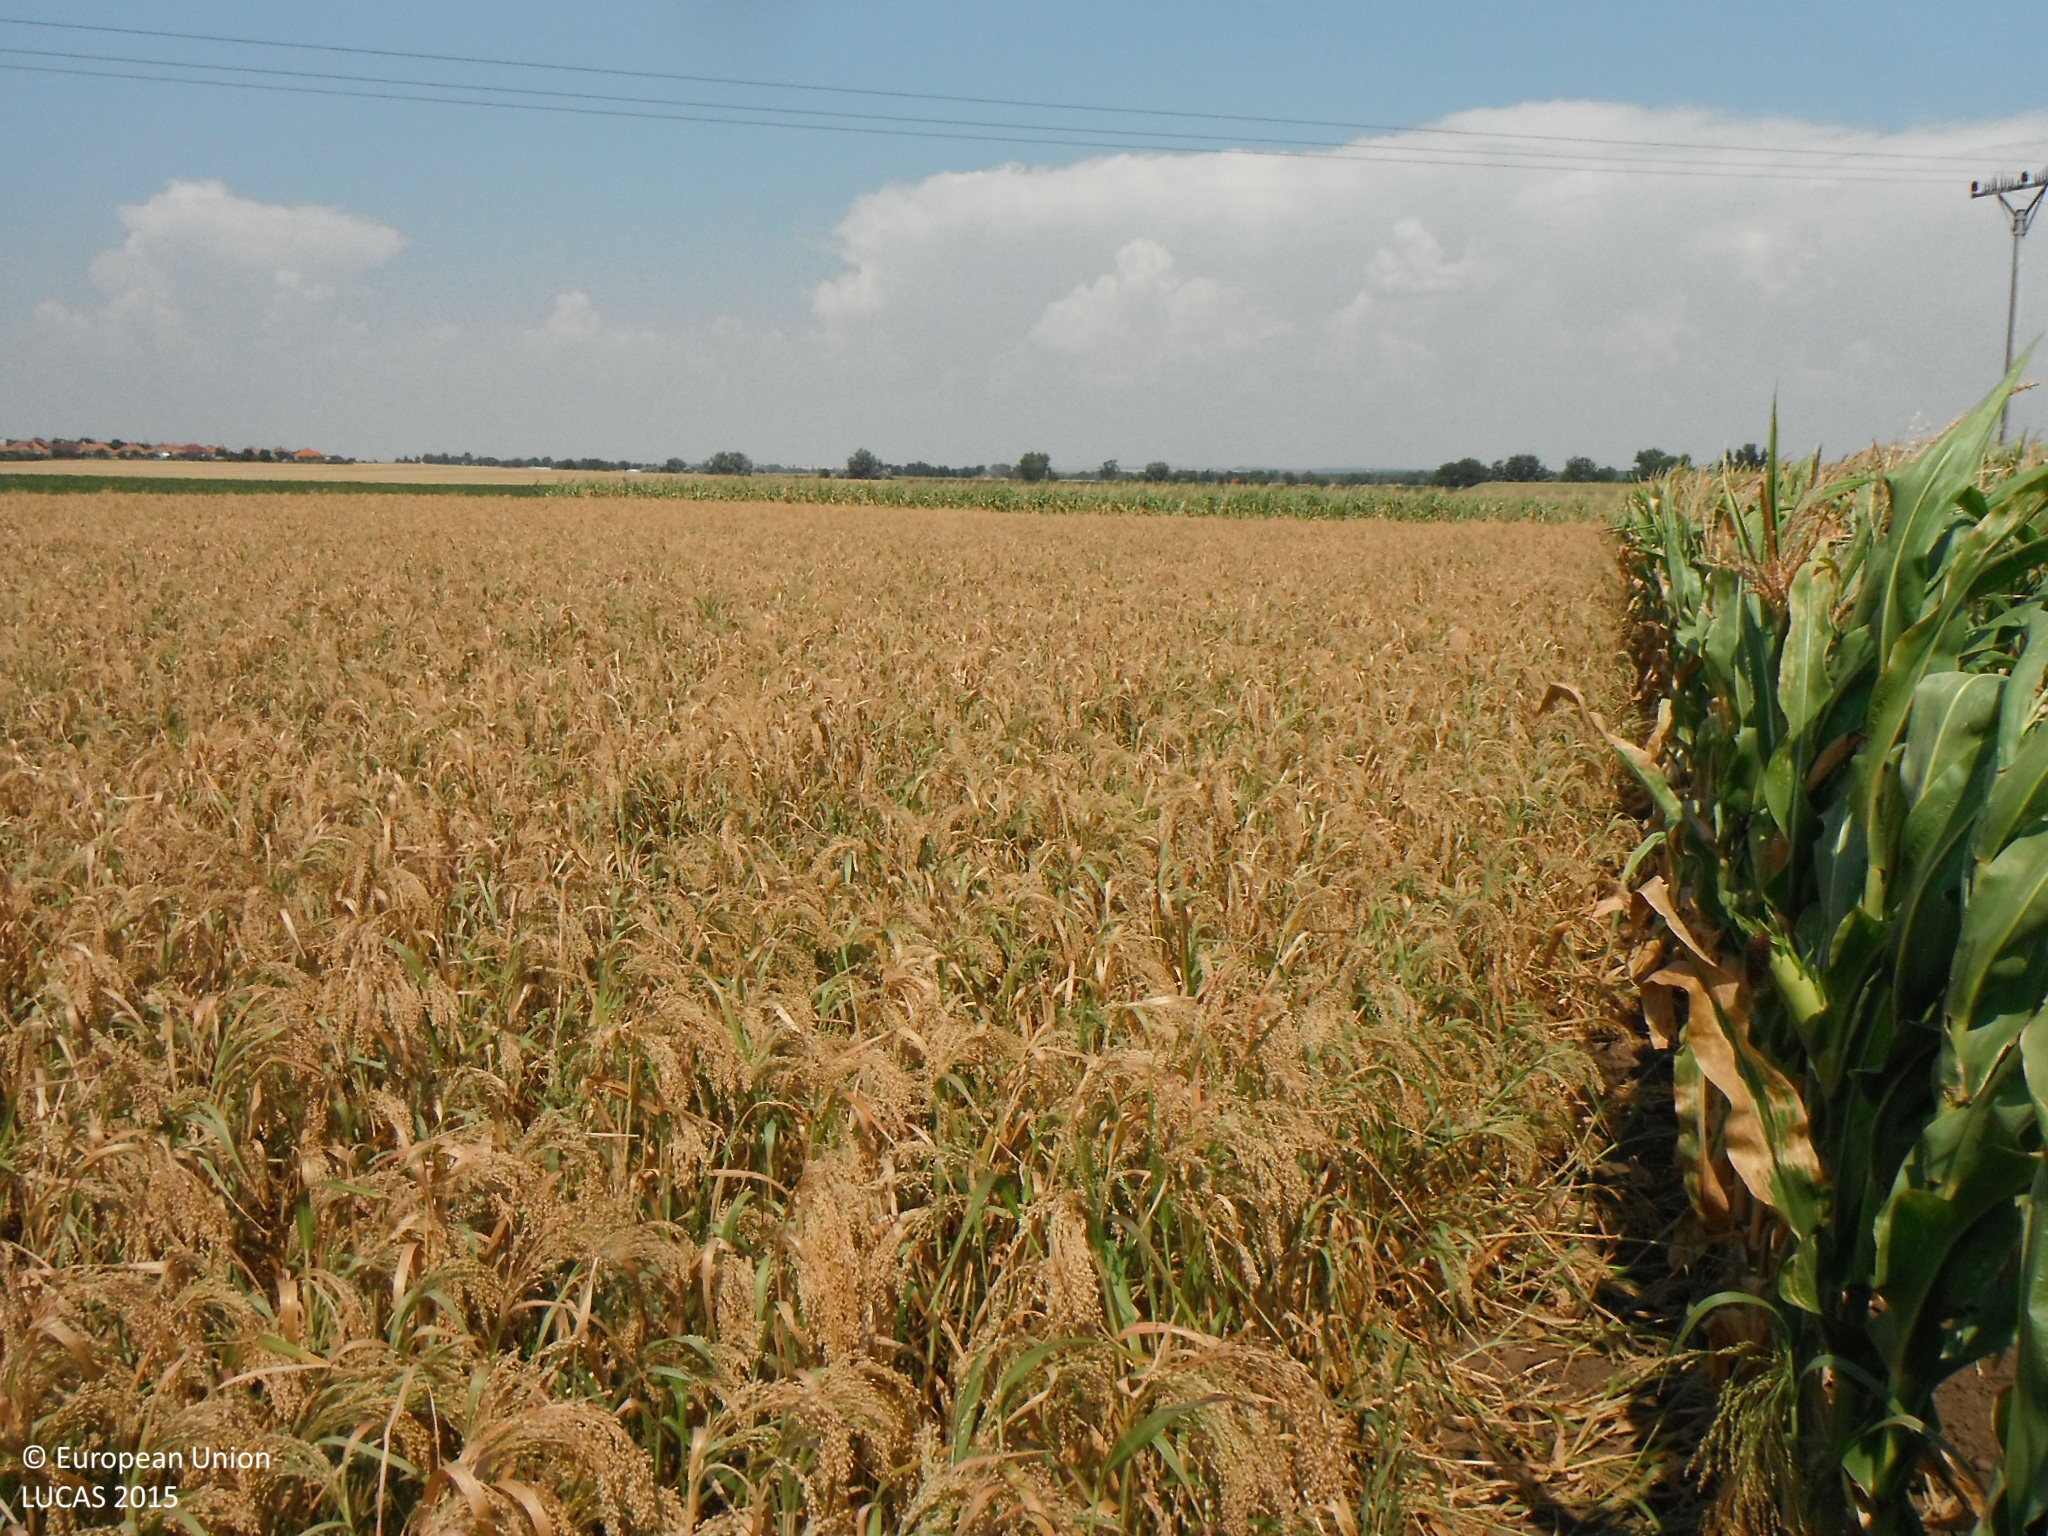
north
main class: Cropland
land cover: Maize
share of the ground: > 75 %
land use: Agriculture (excluding fallow land and kitchen gardens)
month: August
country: SK
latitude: 47.9840
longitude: 18.2808
